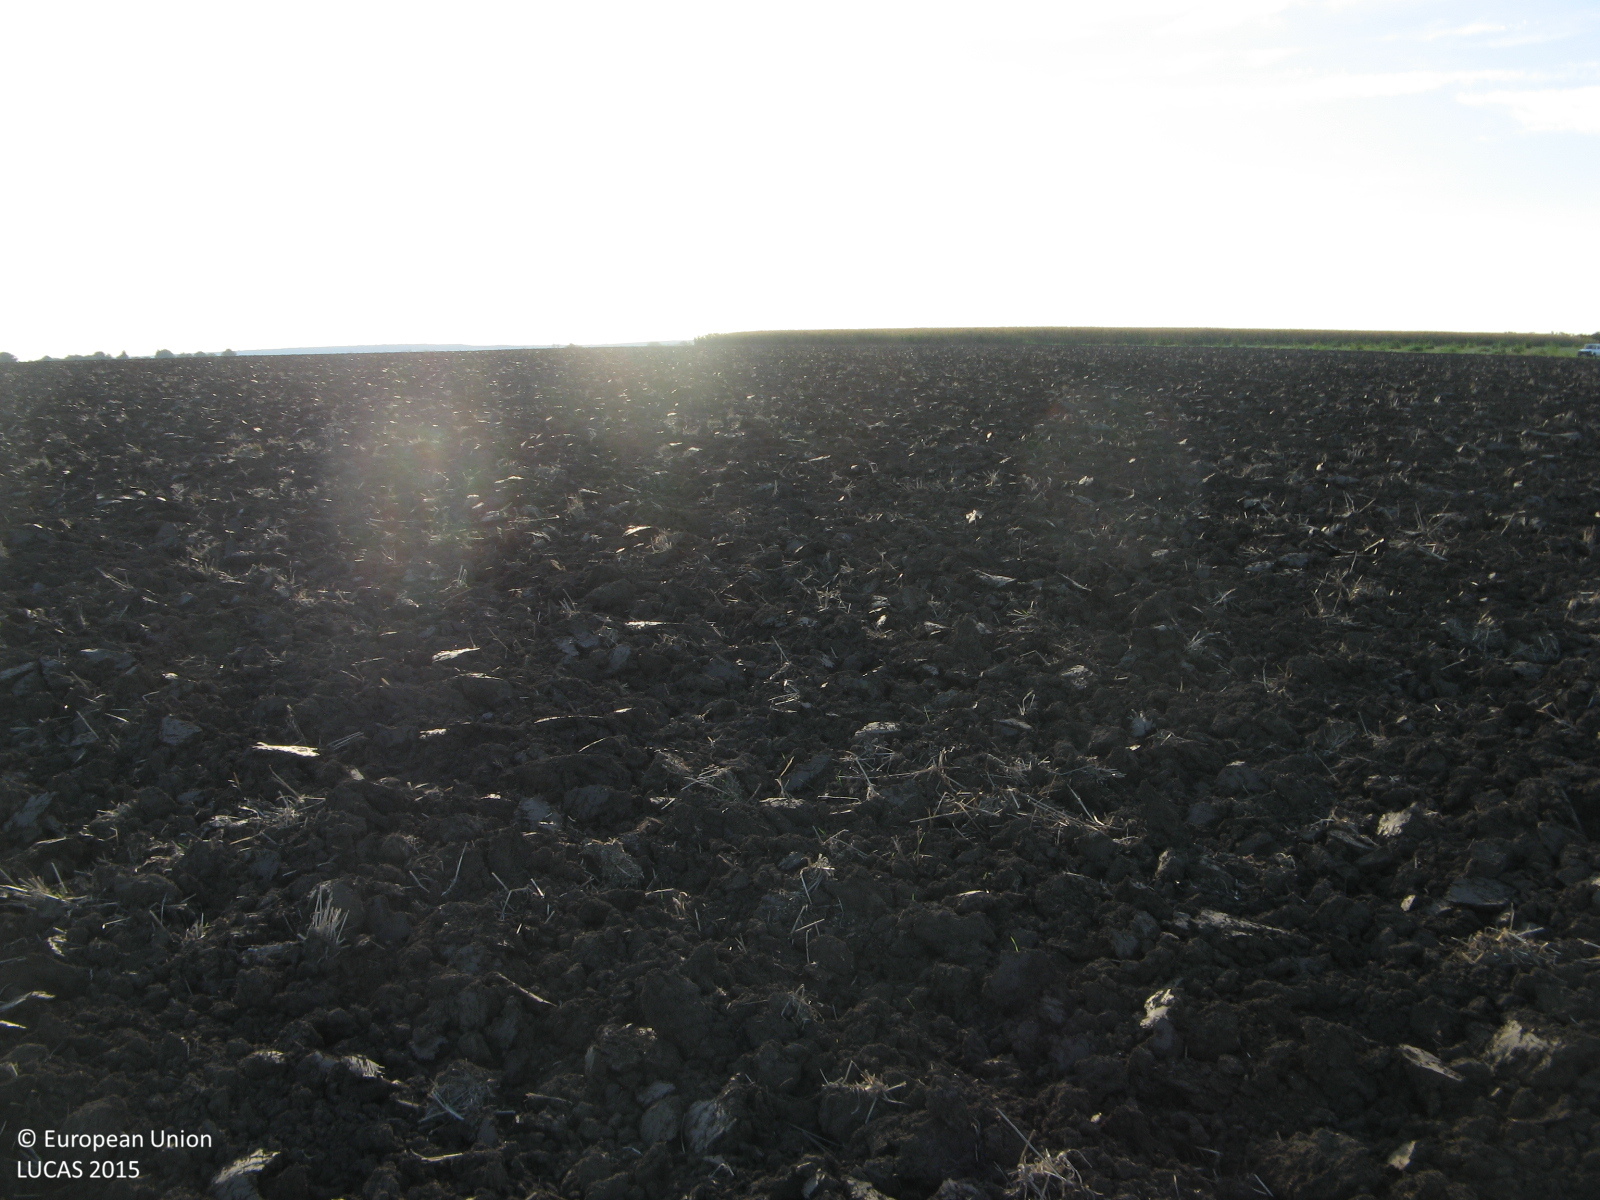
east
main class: Cropland
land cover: Common wheat
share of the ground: < 10 %
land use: Agriculture (excluding fallow land and kitchen gardens)
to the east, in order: Common wheat
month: September
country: BG
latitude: 43.7614
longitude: 26.1091
